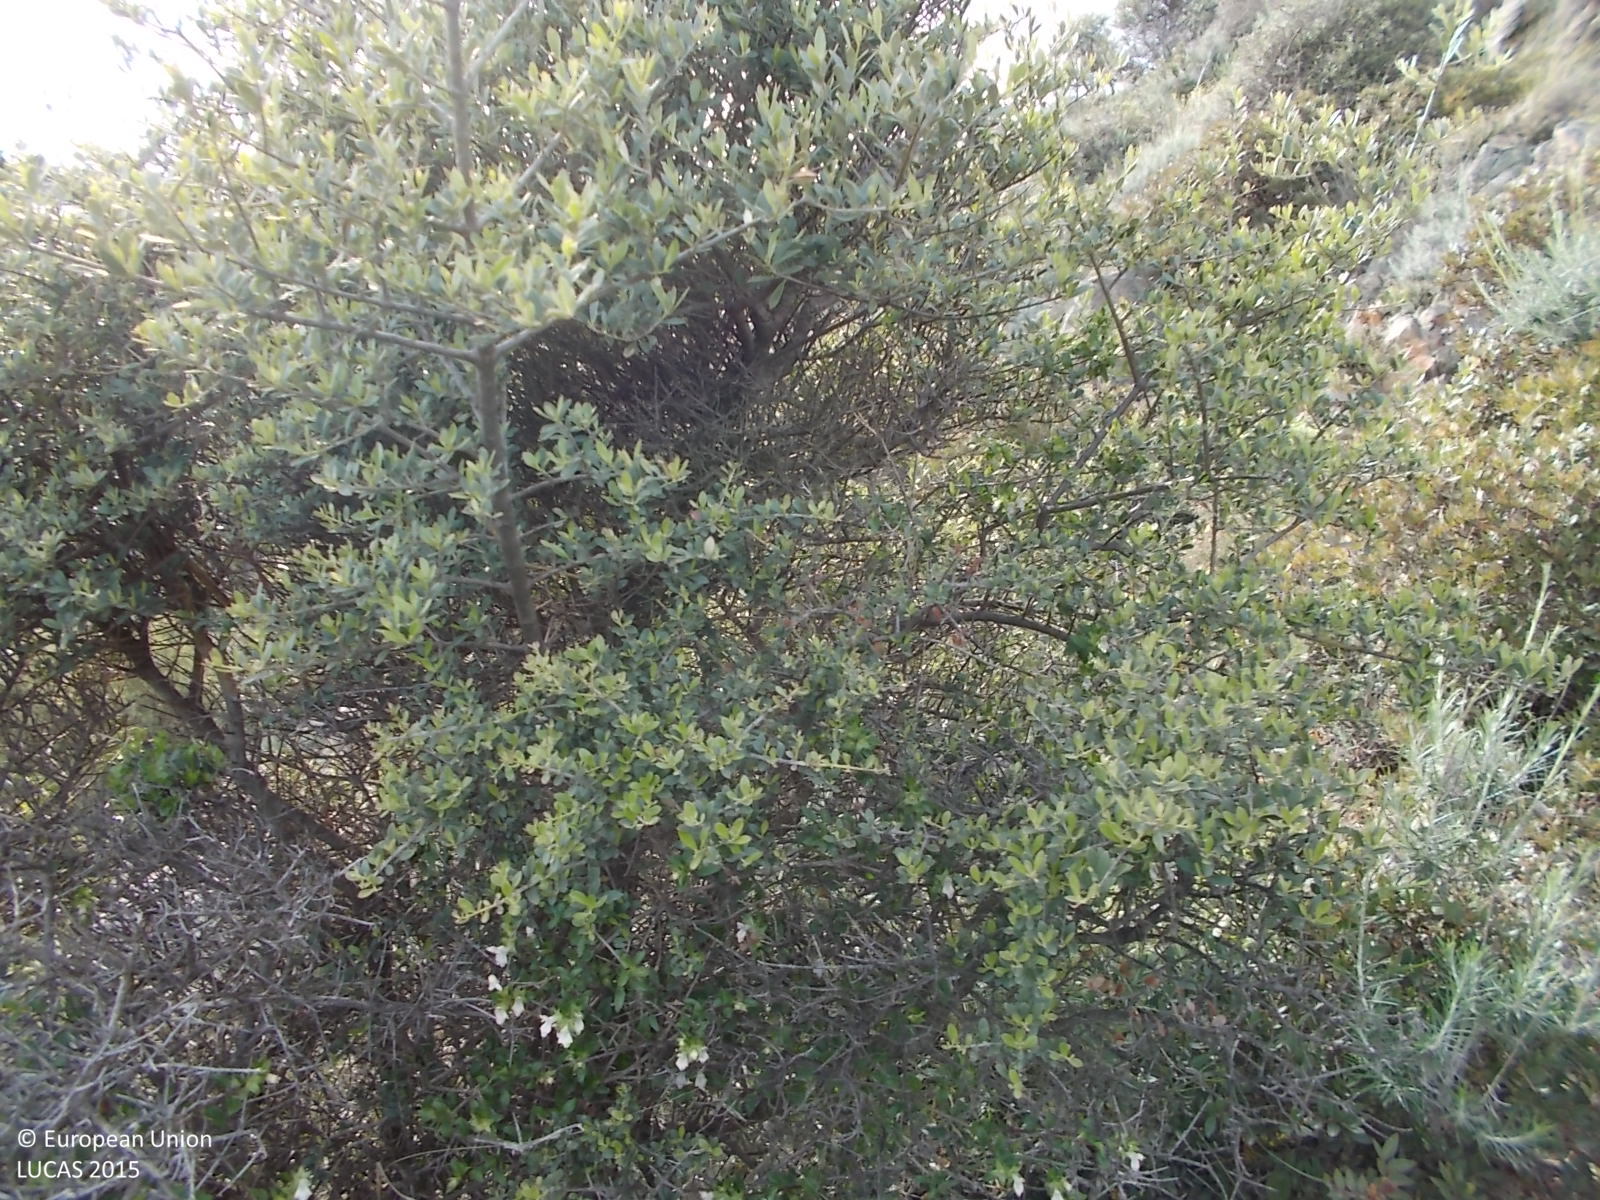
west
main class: Shrubland
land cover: Shrubland without tree cover
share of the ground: > 75 %
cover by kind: shrubs 85 %, unconsolidated bare surface 15 %
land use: Semi-natural and natural areas not in use
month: April
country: CY
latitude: 34.8871
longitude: 33.4388
